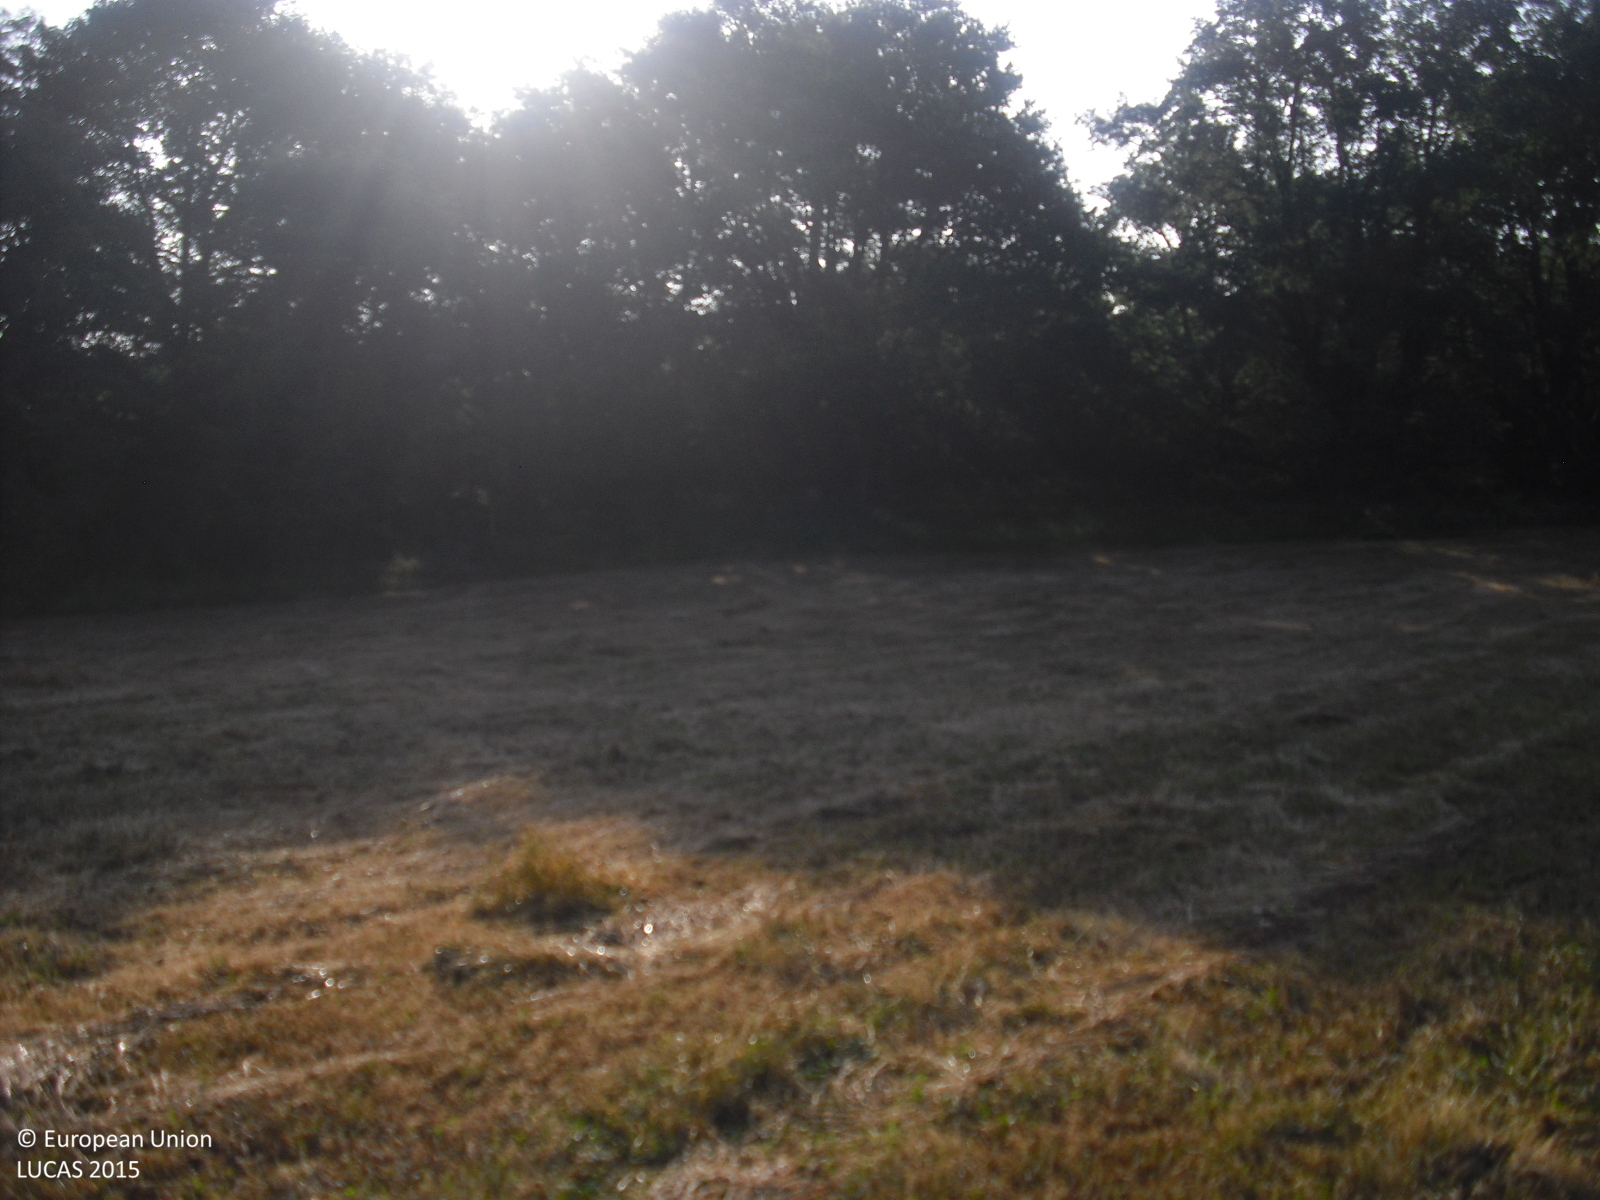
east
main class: Cropland
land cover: Temporary grasslands
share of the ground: > 75 %
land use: Agriculture (excluding fallow land and kitchen gardens)
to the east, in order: Temporary grasslands; Ditches and canals; Broadleaved woodland; Dry stone walls; Broadleaved woodland; Pine dominated mixed woodland; Ditches and canals; Tracks; Shruby margins; Electric lines; Ditches and canals; Broadleaved woodland
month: June
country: ES
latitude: 42.5391
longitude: -7.7941
